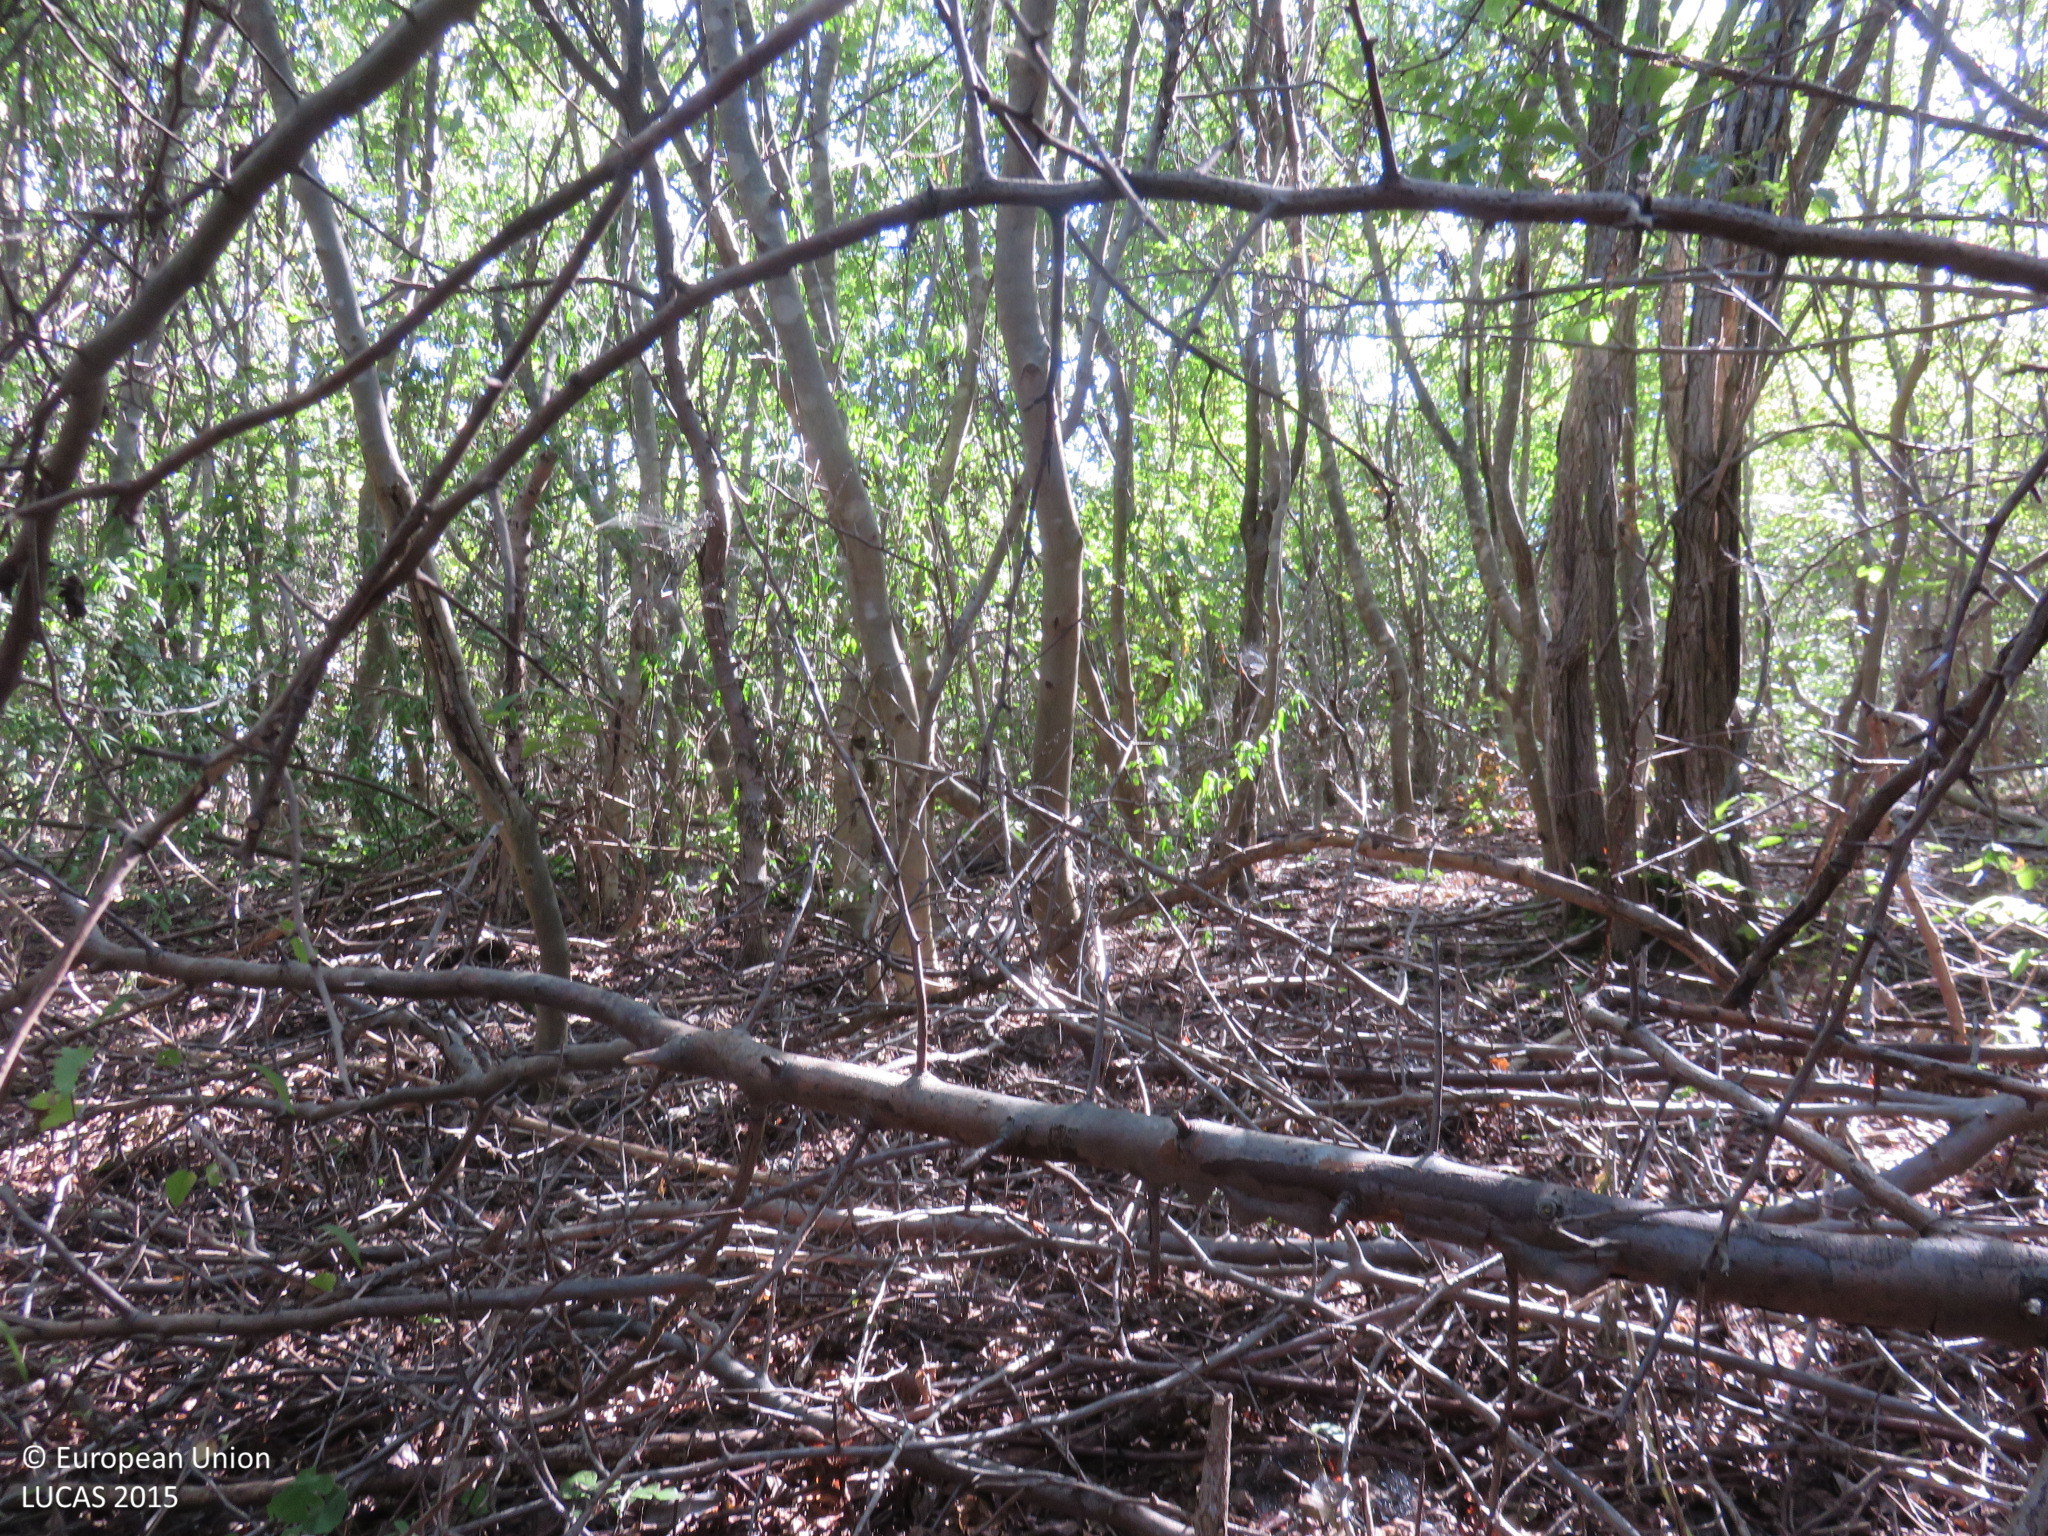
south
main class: Woodland
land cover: Broadleaved woodland
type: mesophytic deciduous forest
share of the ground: > 75 %
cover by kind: broadleaved forest trees 95 %, shrubs 5 %
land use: Forestry
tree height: < 5 m
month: September
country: BG
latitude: 43.6647
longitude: 24.9408
